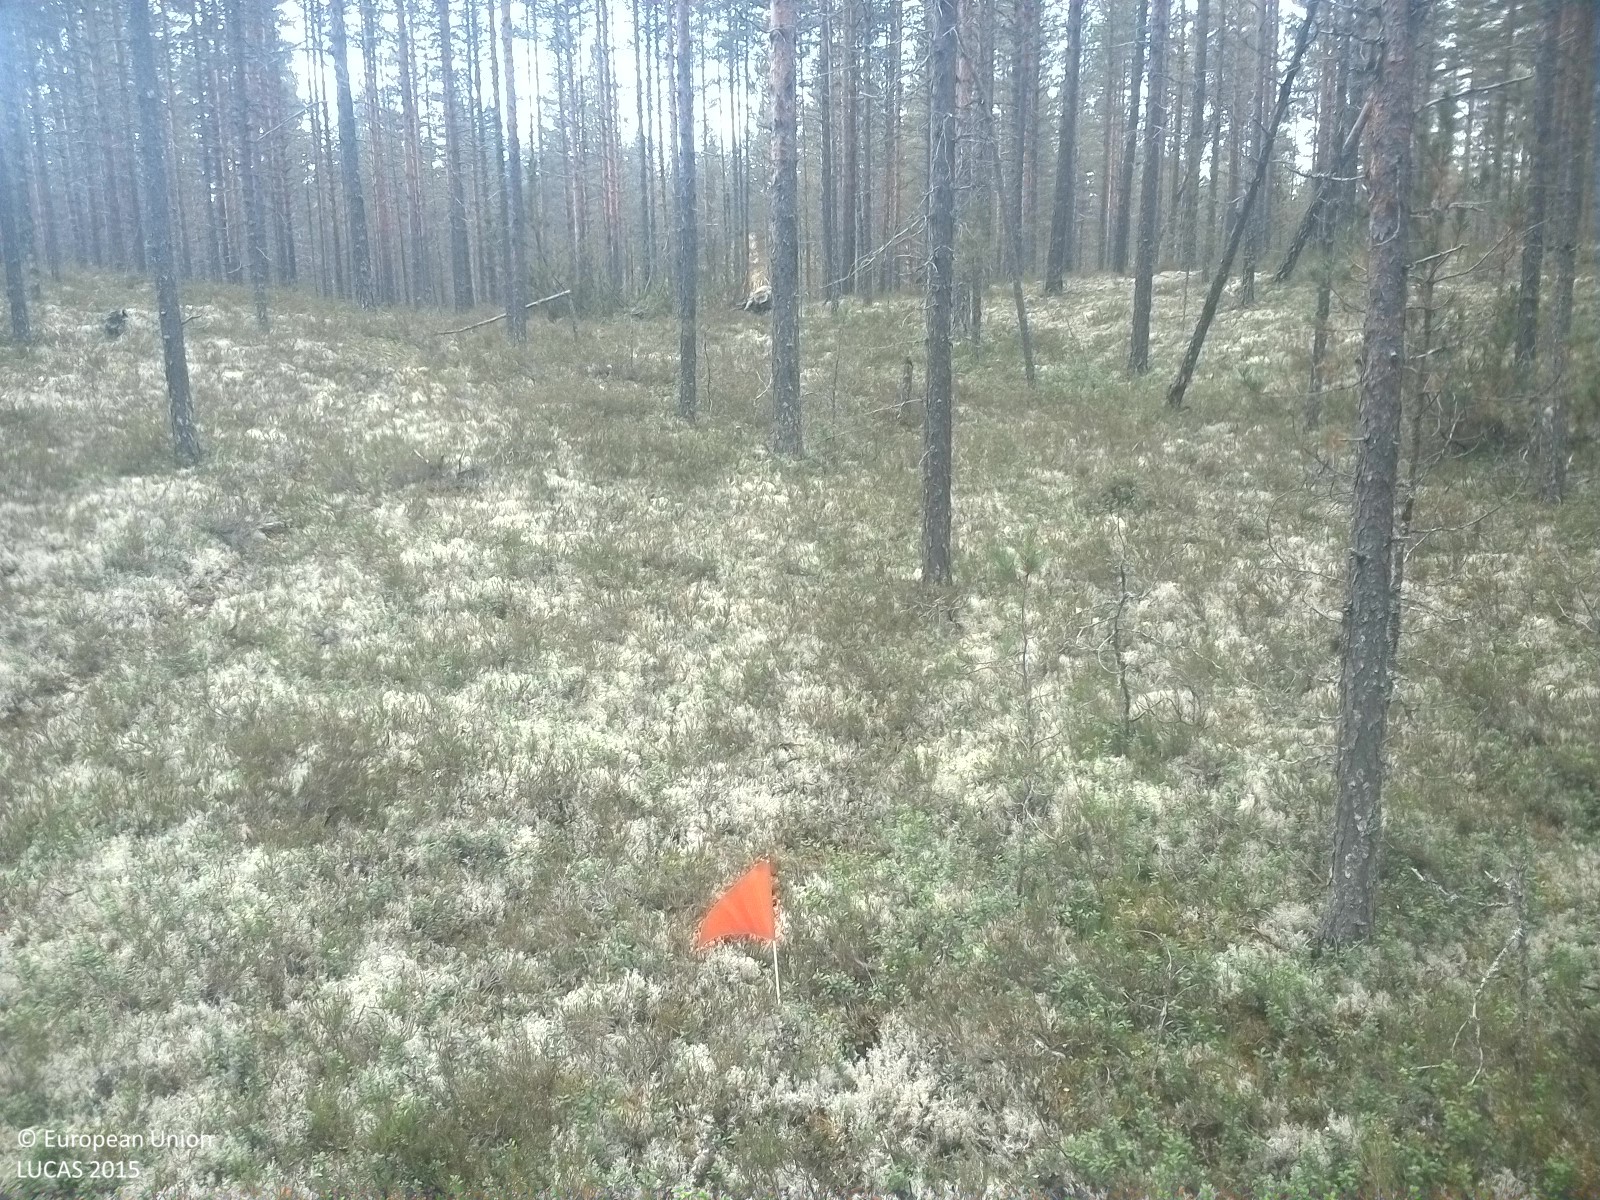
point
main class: Woodland
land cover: Pine dominated coniferous woodland
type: boreal forest
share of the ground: 50 - 75 %
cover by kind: coniferous forest trees 50 %, lichens and mosses 40 %, shrubs 10 %
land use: Forestry
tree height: > 5 m
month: September
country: SE
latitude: 62.2033
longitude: 15.5361
